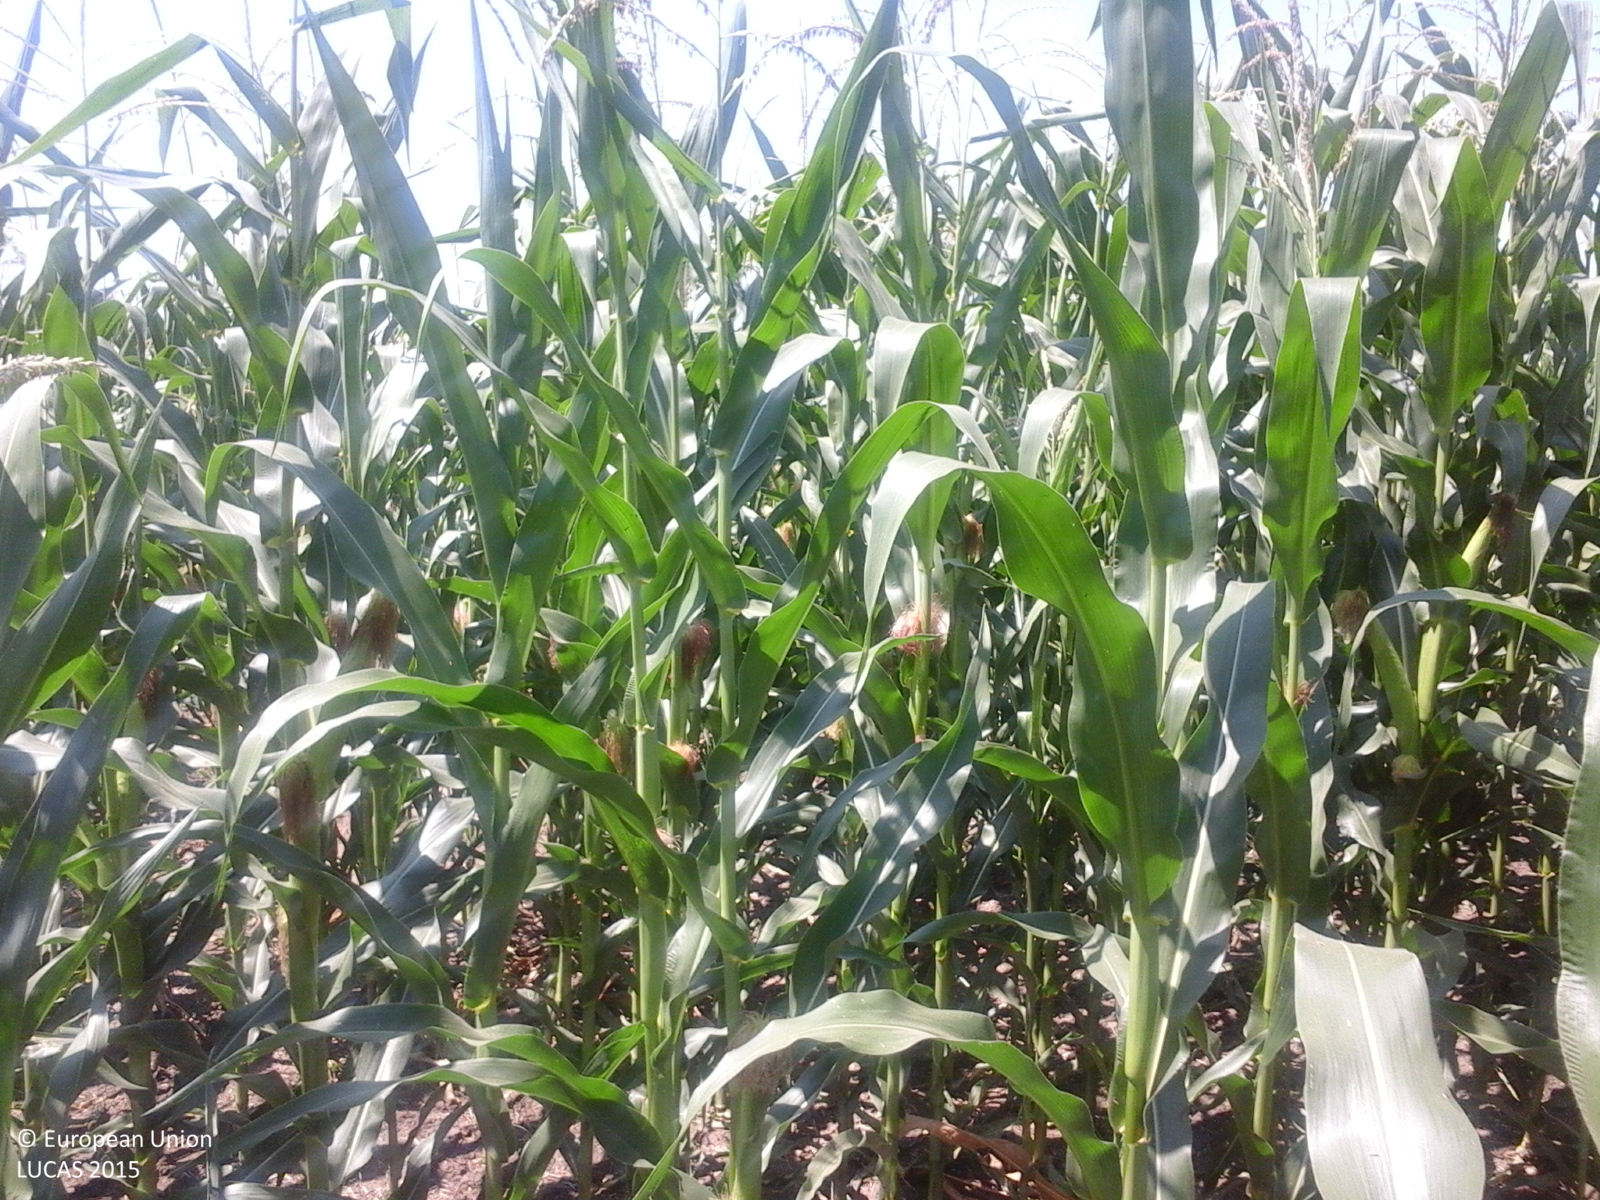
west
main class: Cropland
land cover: Maize
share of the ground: > 75 %
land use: Agriculture (excluding fallow land and kitchen gardens)
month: July
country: RO
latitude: 44.7198
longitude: 26.7769
